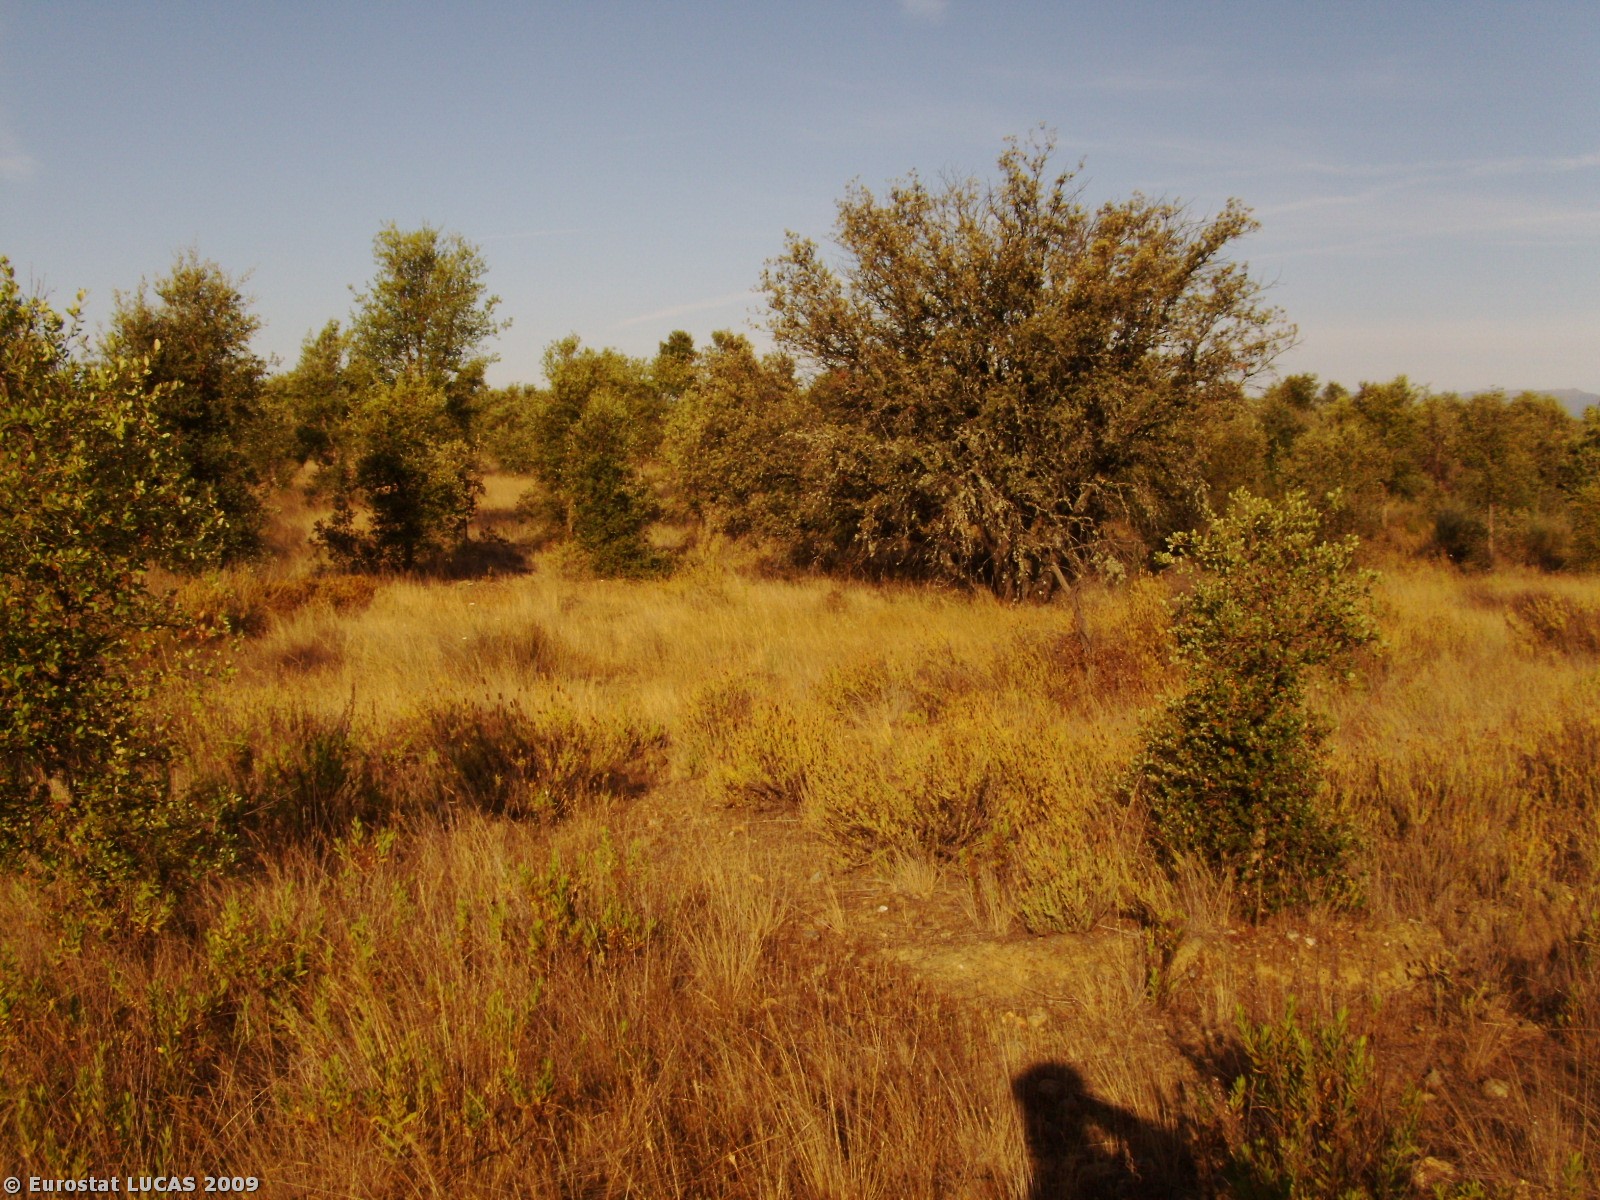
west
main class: Woodland
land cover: Broadleaved woodland
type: broadleaved evergreen forest
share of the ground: 25 - 50 %
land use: Forestry
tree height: > 5 m
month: June
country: PT
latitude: 40.0903
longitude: -7.2572
